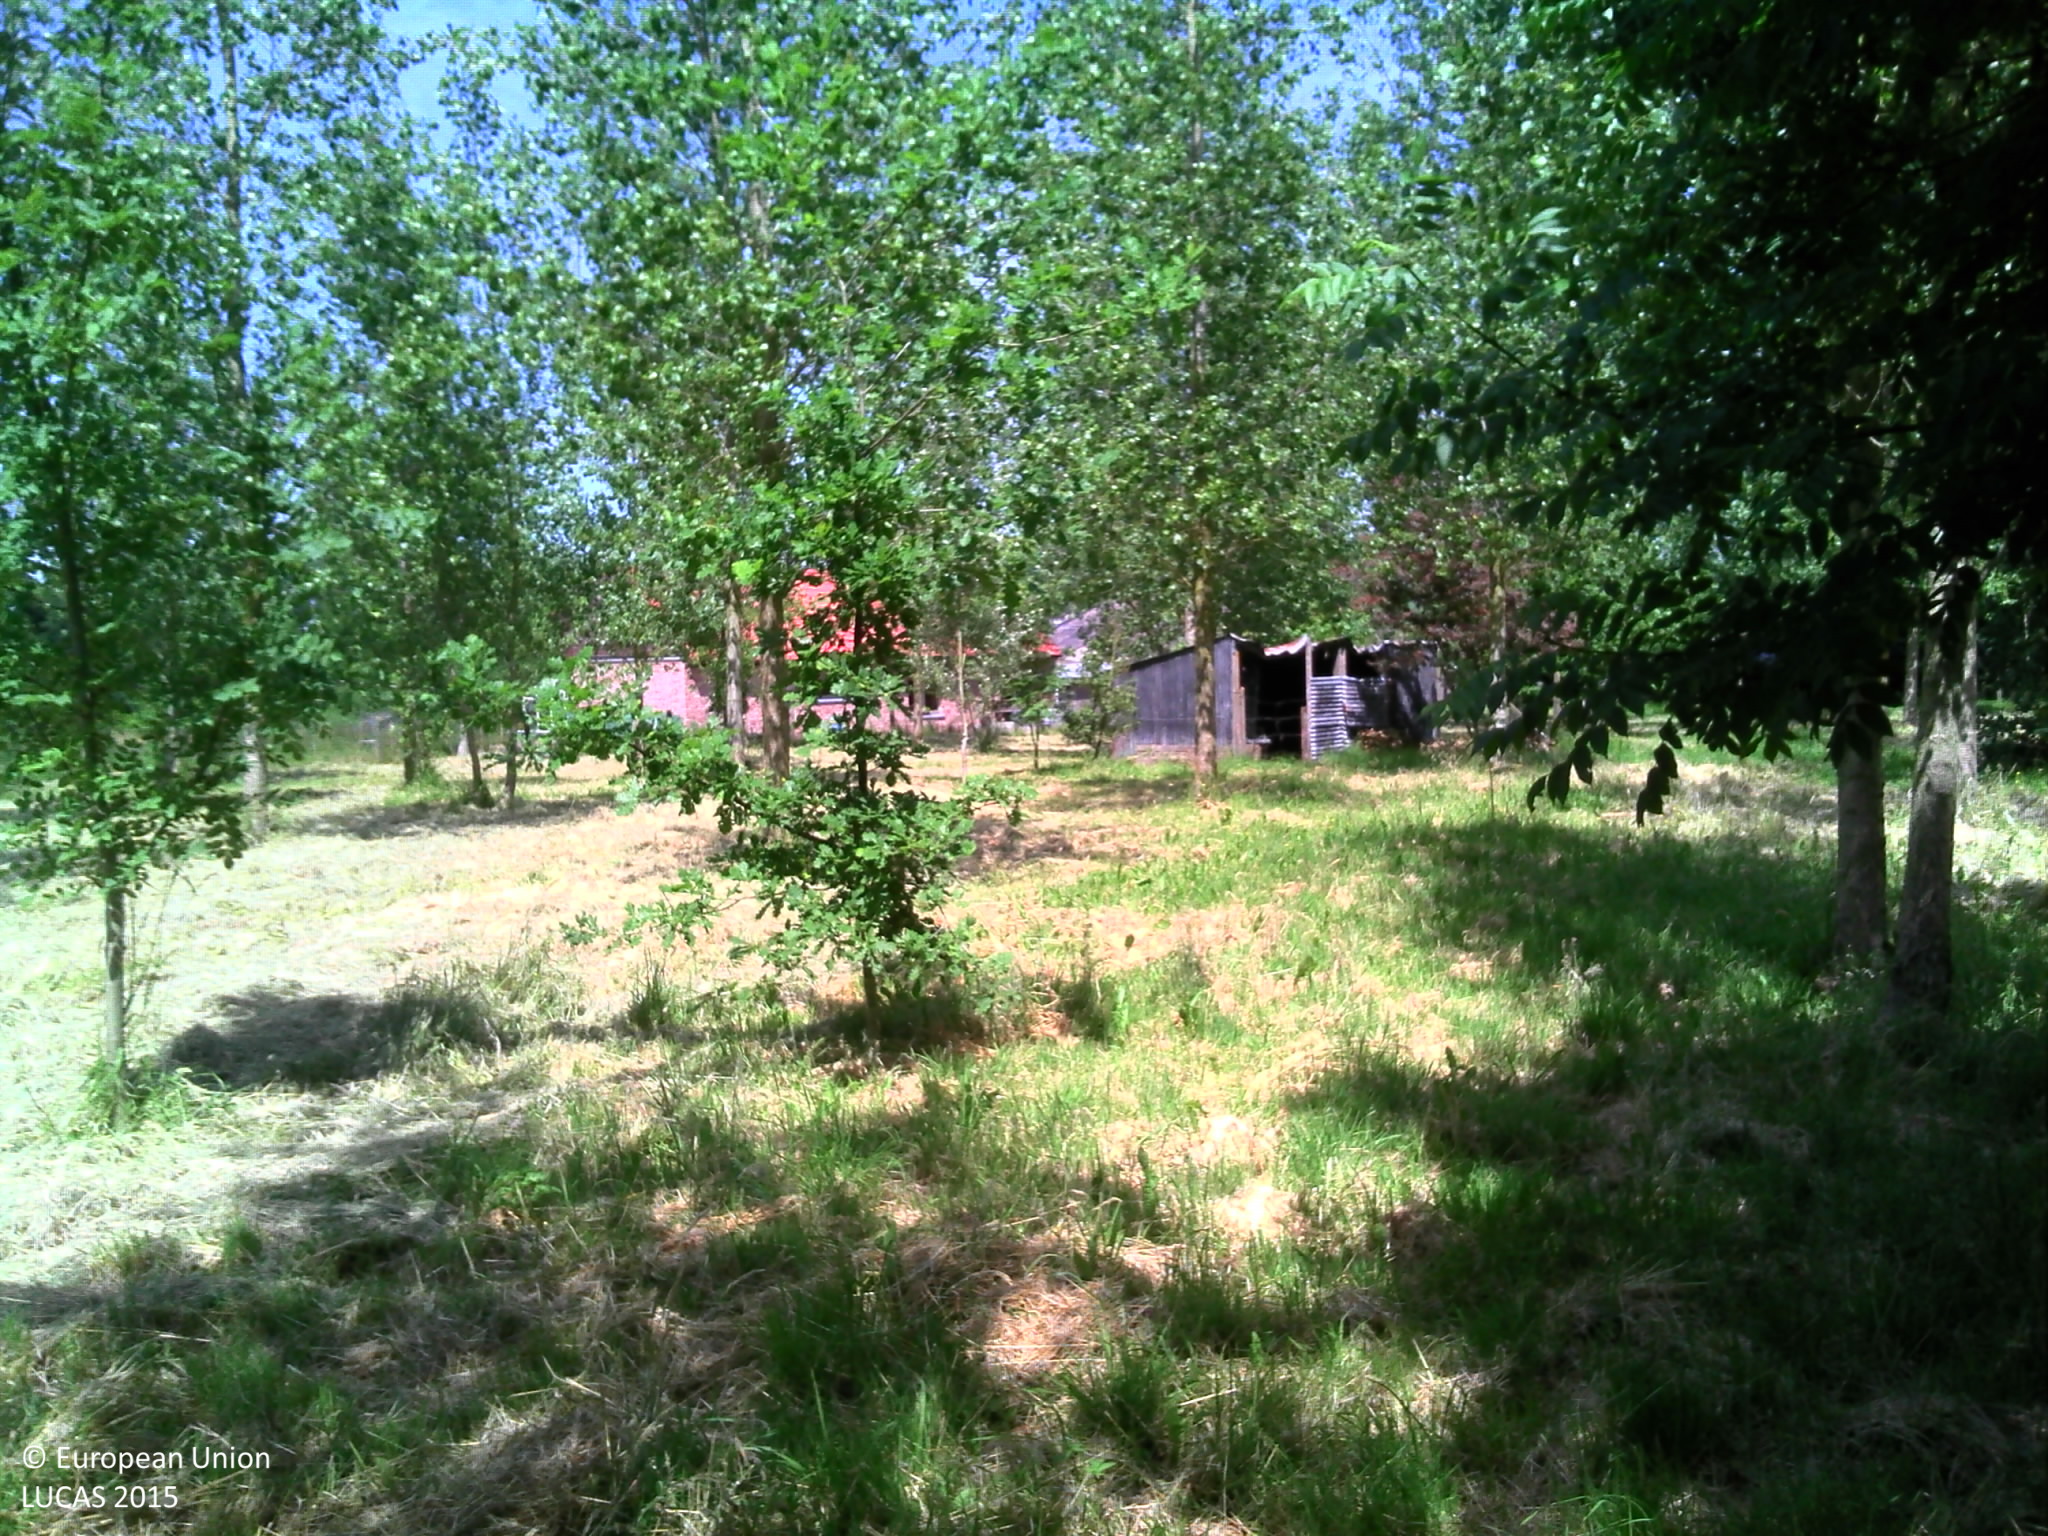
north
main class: Woodland
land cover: Broadleaved woodland
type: exotic forest
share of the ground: > 75 %
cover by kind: broadleaved forest trees 100 %
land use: Forestry
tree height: > 5 m
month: June
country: BE
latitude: 50.7456
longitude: 3.6295
